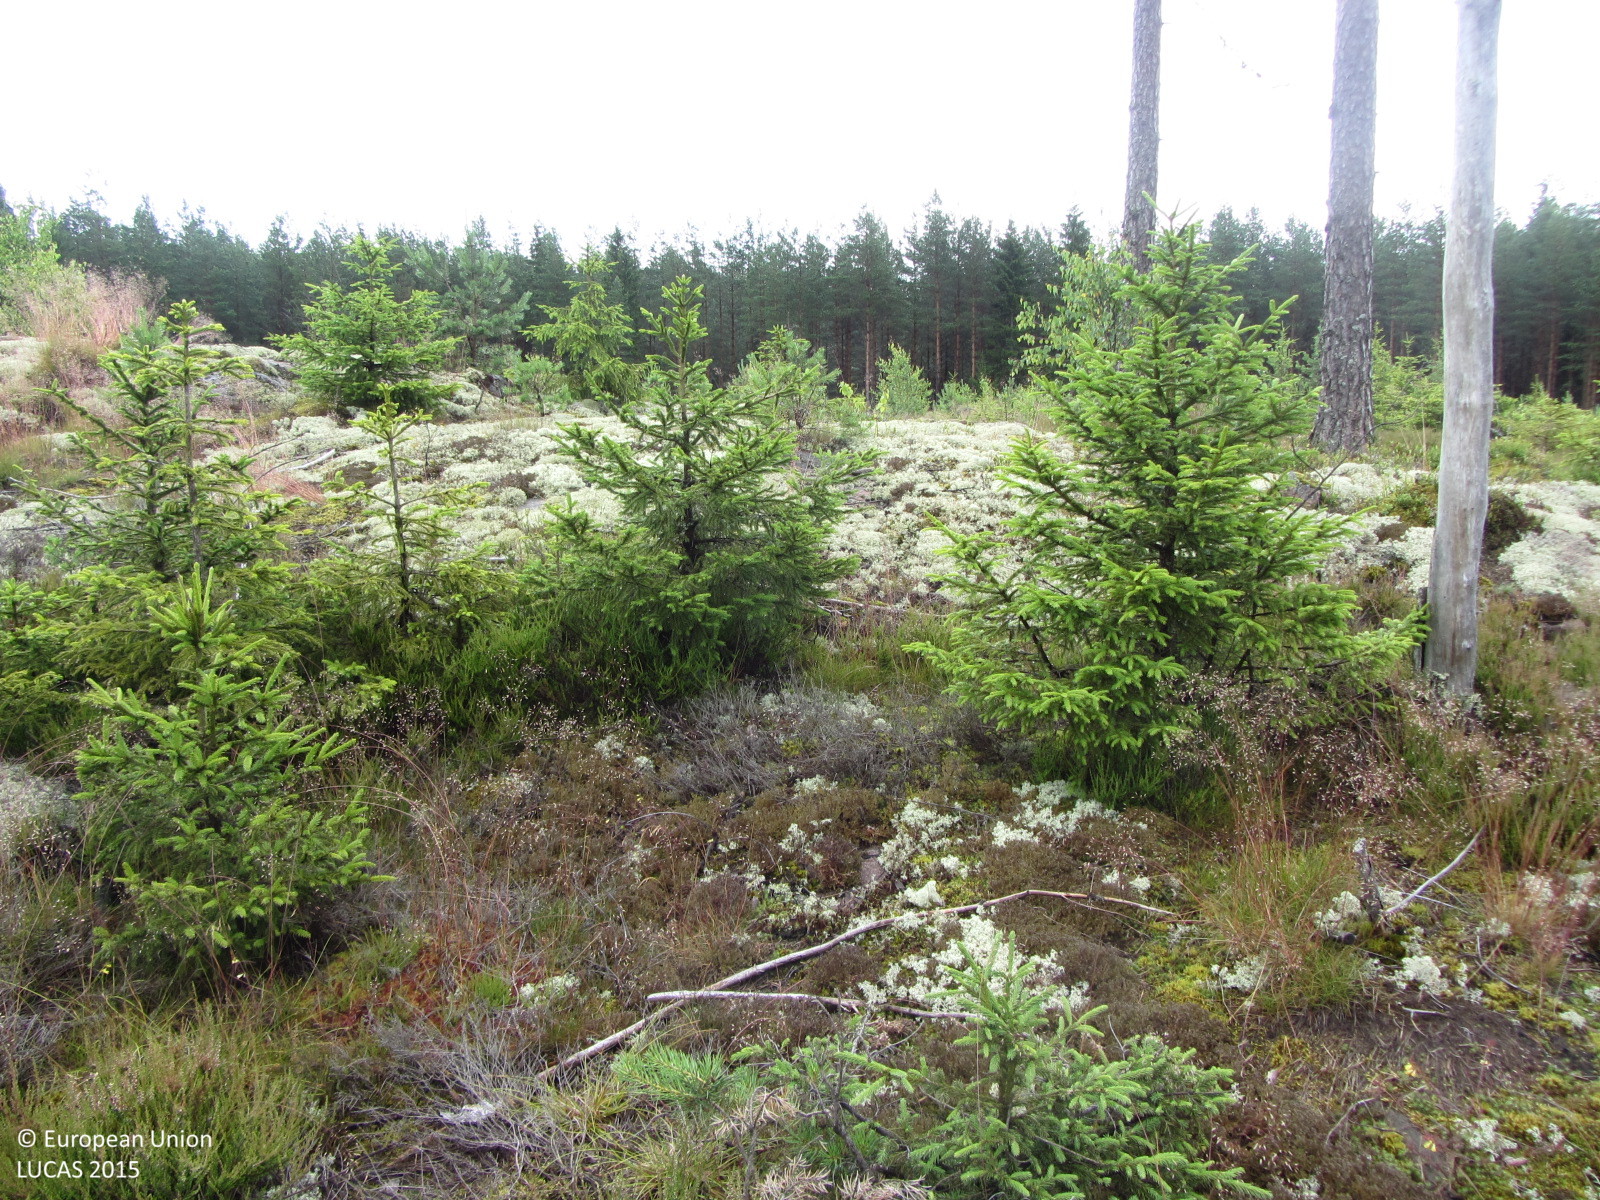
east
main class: Woodland
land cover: Other mixed woodland
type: boreal forest
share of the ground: 10 - 25 %
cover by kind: lichens and mosses 40 %, shrubs 20 %, herbaceous plants 20 %, coniferous forest trees 15 %, broadleaved forest trees 5 %
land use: Forestry
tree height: < 5 m
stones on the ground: 10 - 25 %
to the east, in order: Other mixed woodland; Pine dominated coniferous woodland; Ditches and canals; Pine dominated coniferous woodland; Ditches and canals; Pine dominated coniferous woodland; Other coniferous woodland
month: July
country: FI
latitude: 60.0935
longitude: 24.0715
